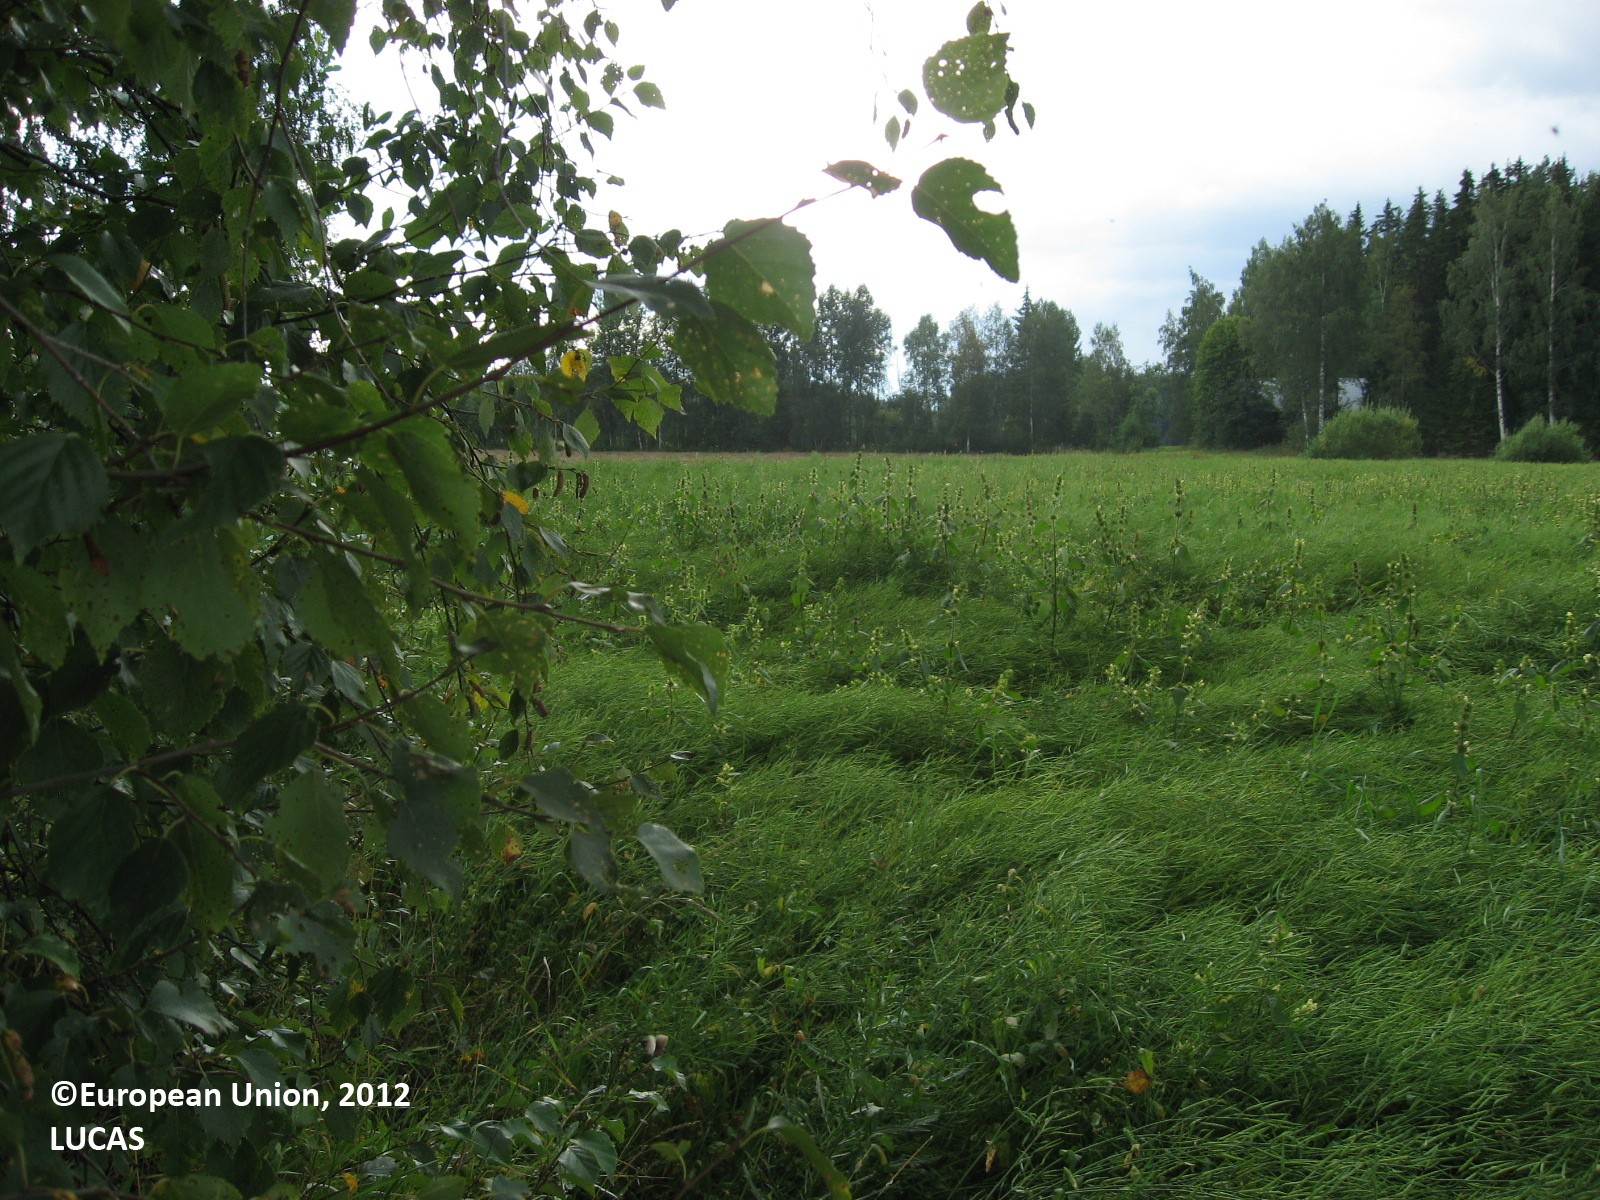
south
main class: Cropland
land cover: Rape and turnip rape
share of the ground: > 75 %
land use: Agriculture (excluding fallow land and kitchen gardens)
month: August
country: FI
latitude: 60.6541
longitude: 25.2124
